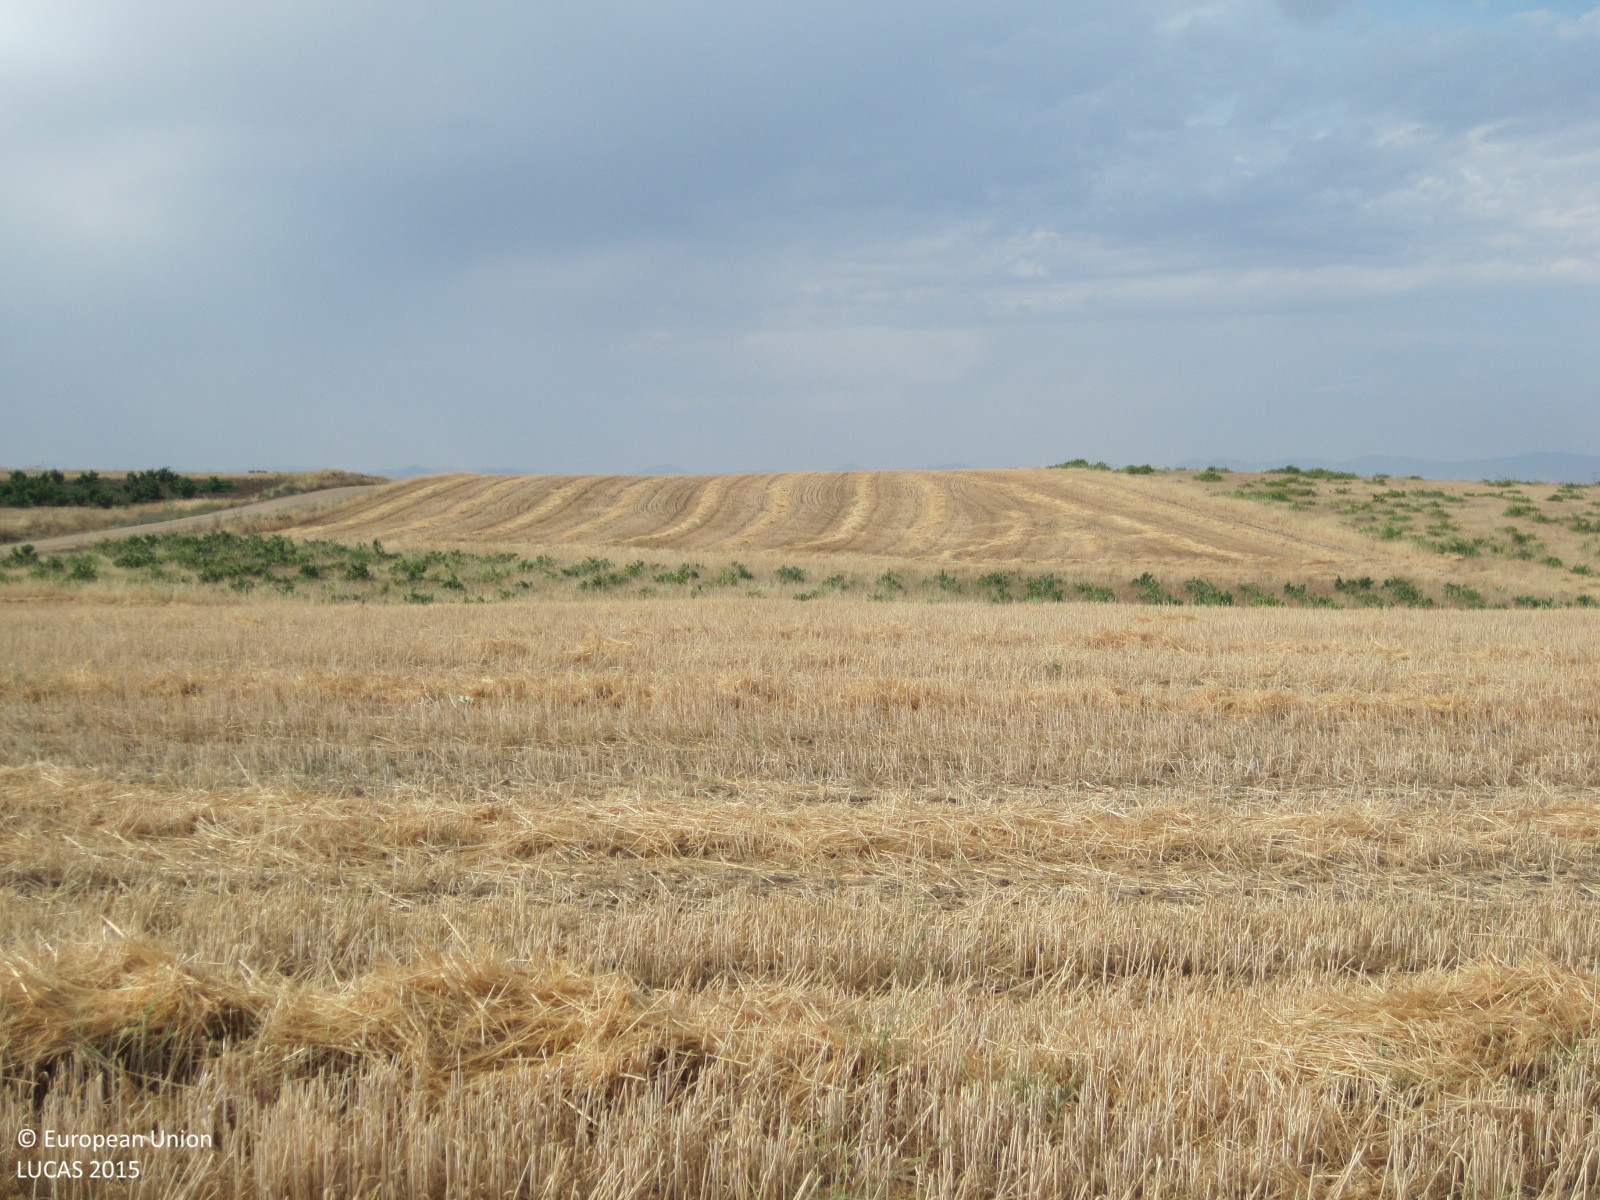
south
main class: Cropland
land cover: Common wheat
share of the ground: < 10 %
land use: Agriculture (excluding fallow land and kitchen gardens)
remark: Harvested field
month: July
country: ES
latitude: 40.0487
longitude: -4.2348
